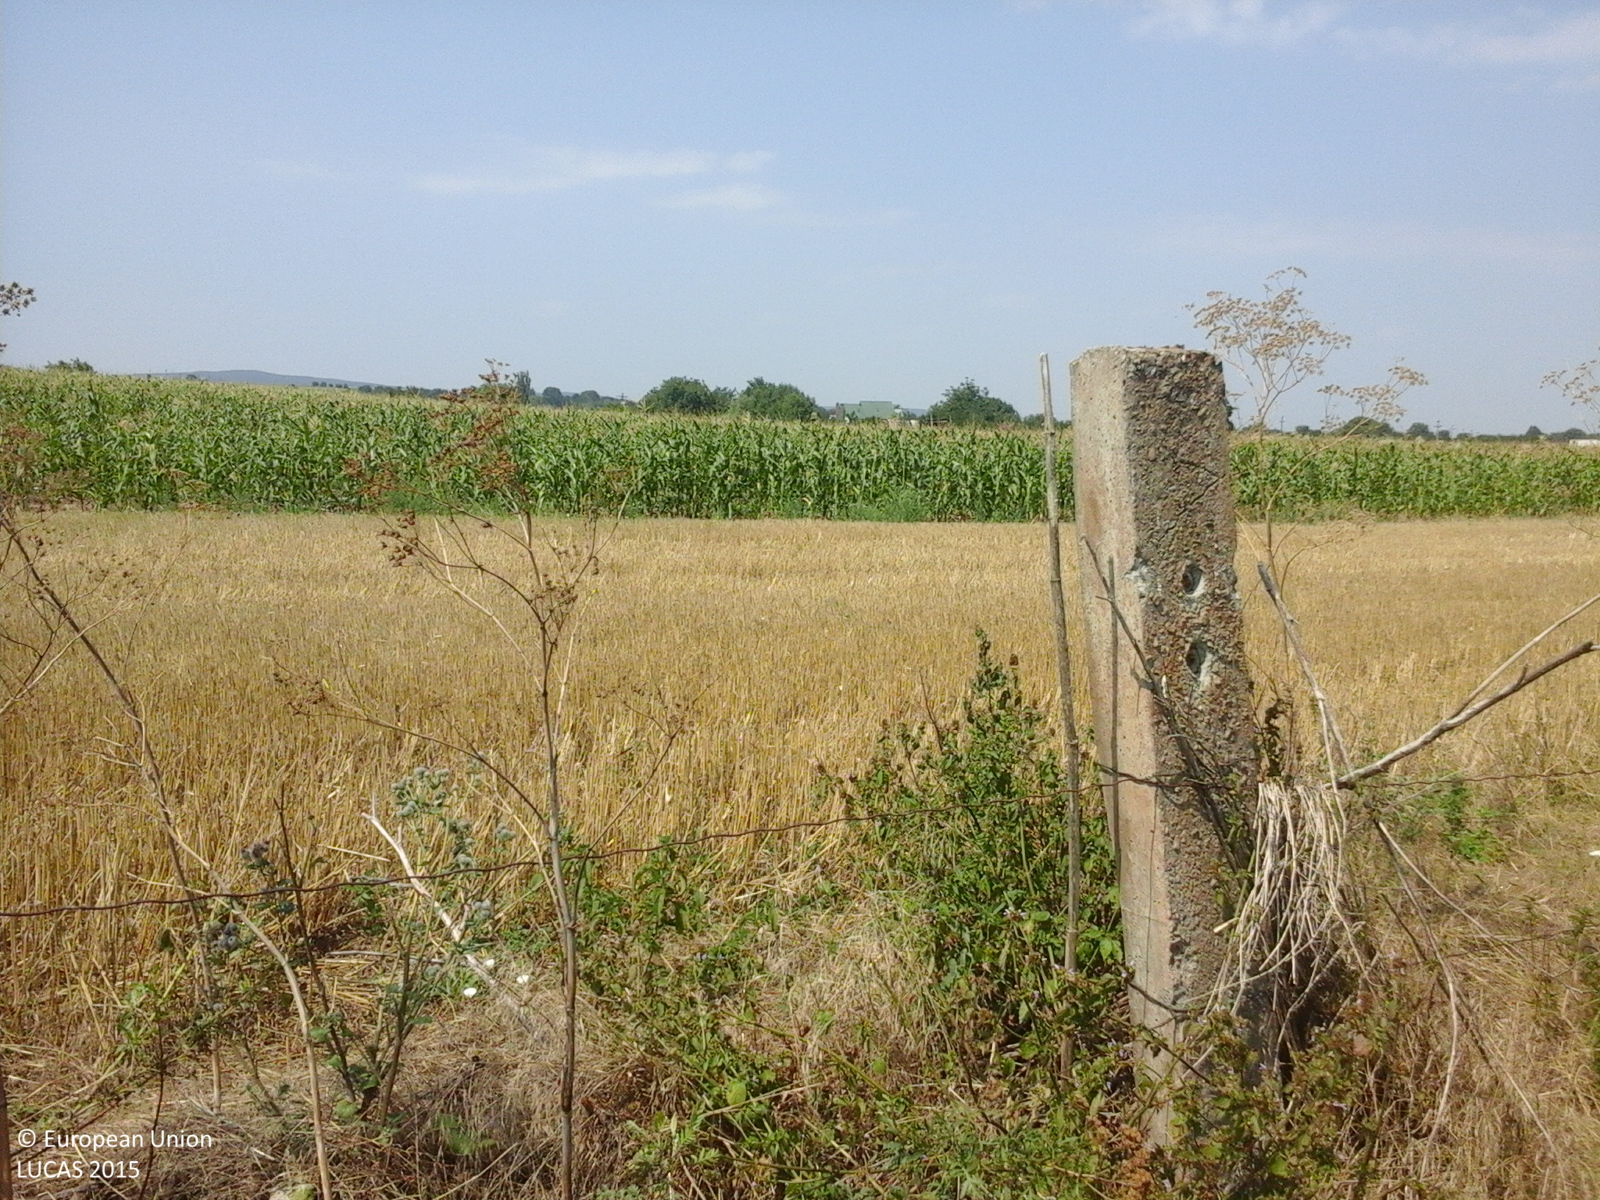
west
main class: Cropland
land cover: Maize
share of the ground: > 75 %
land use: Agriculture (excluding fallow land and kitchen gardens)
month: August
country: RO
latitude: 46.1919
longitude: 27.1096
